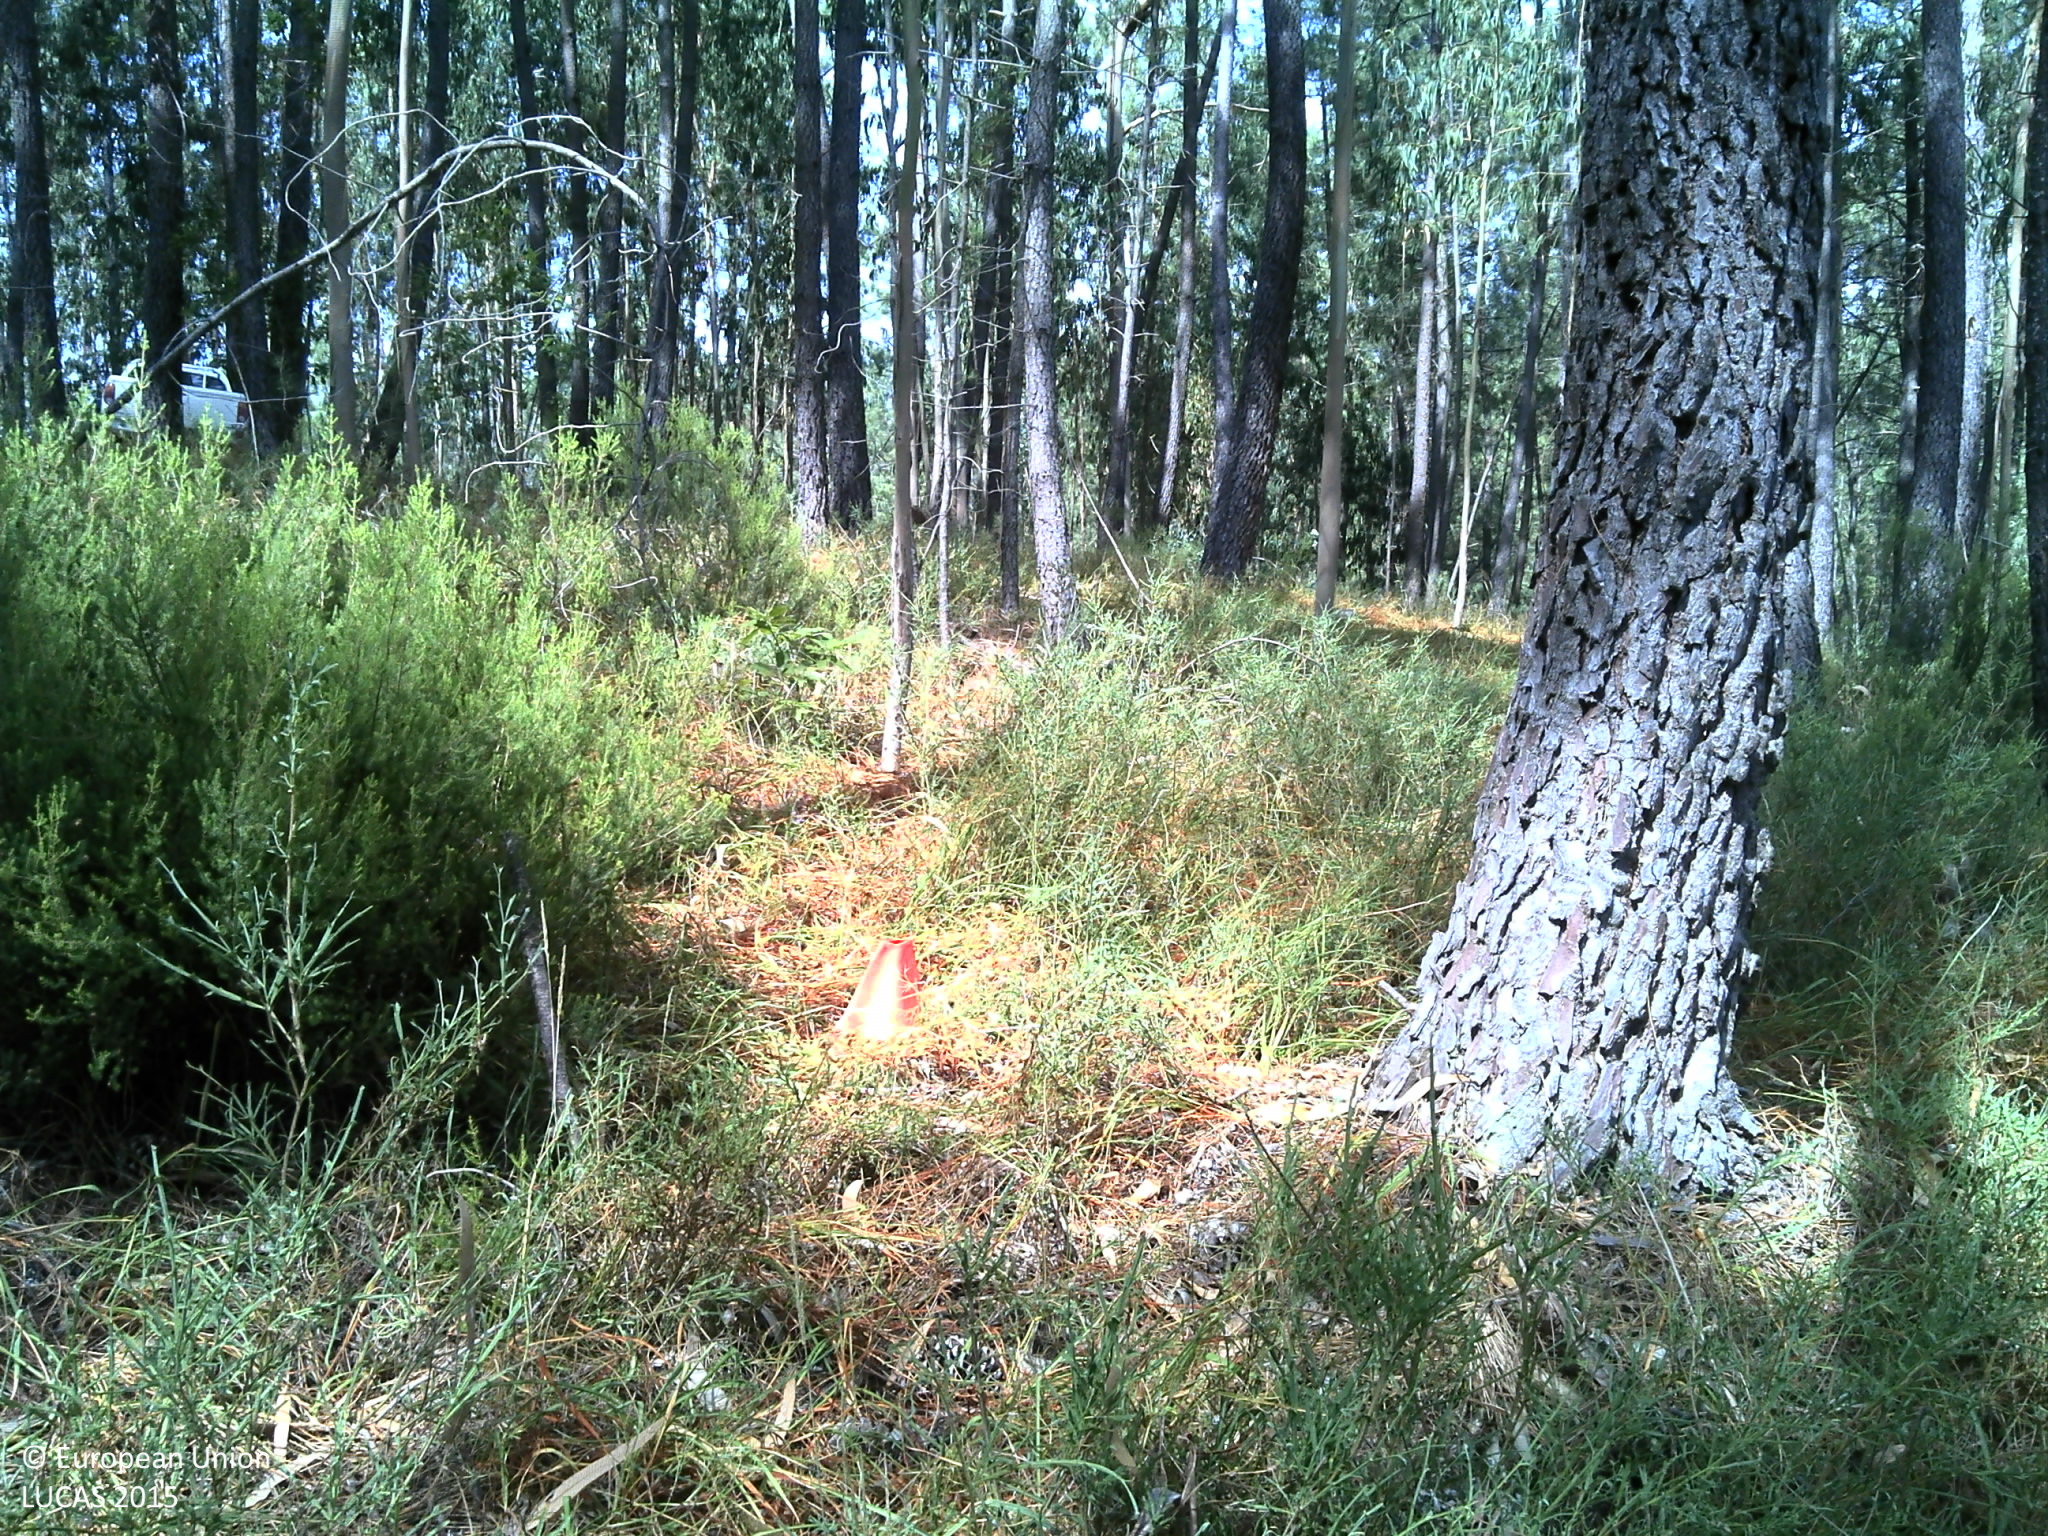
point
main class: Woodland
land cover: Pine dominated mixed woodland
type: coniferous forest of the mediterranean region
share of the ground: 25 - 50 %
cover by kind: shrubs 40 %, coniferous forest trees 15 %, broadleaved forest trees 10 %, consolidated bare surface 10 %, unconsolidated bare surface 10 %
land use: Forestry
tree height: > 5 m
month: July
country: PT
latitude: 39.8959
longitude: -8.1156
